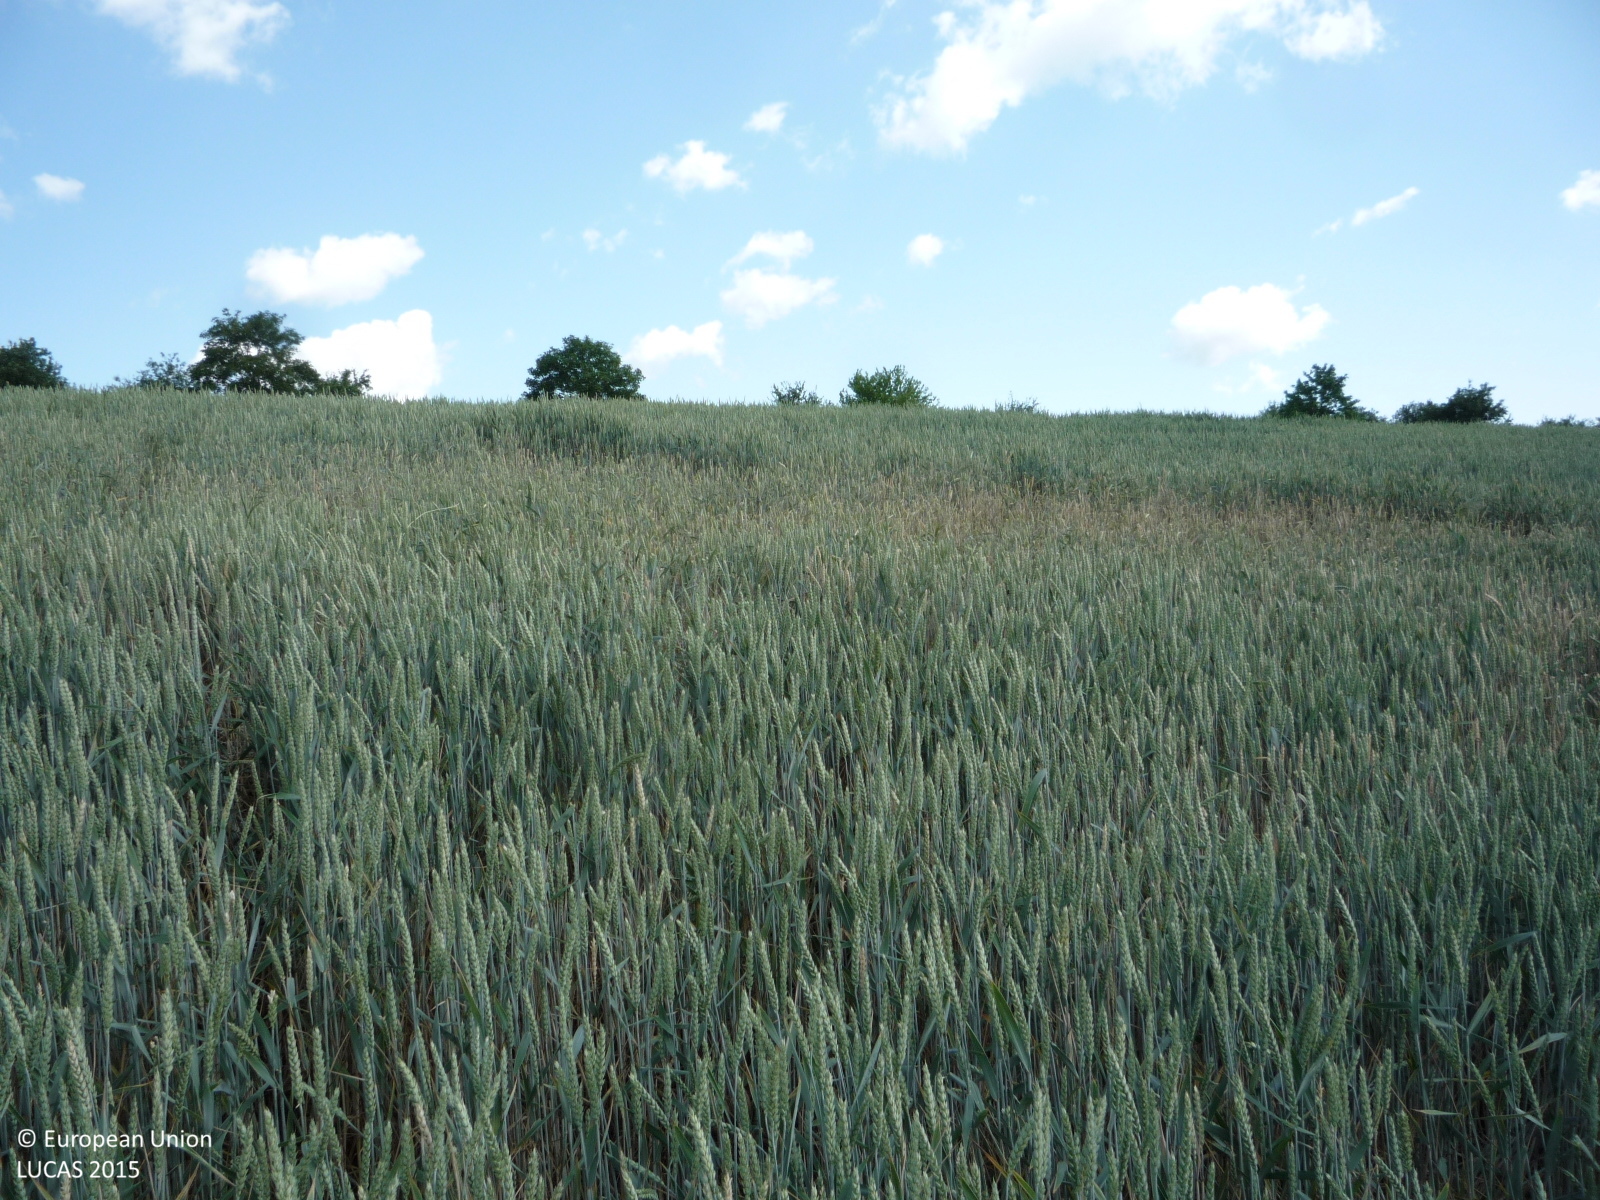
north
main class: Cropland
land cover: Common wheat
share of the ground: > 75 %
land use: Agriculture (excluding fallow land and kitchen gardens)
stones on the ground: < 10 %
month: June
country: CZ
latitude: 49.7448
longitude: 15.1237
